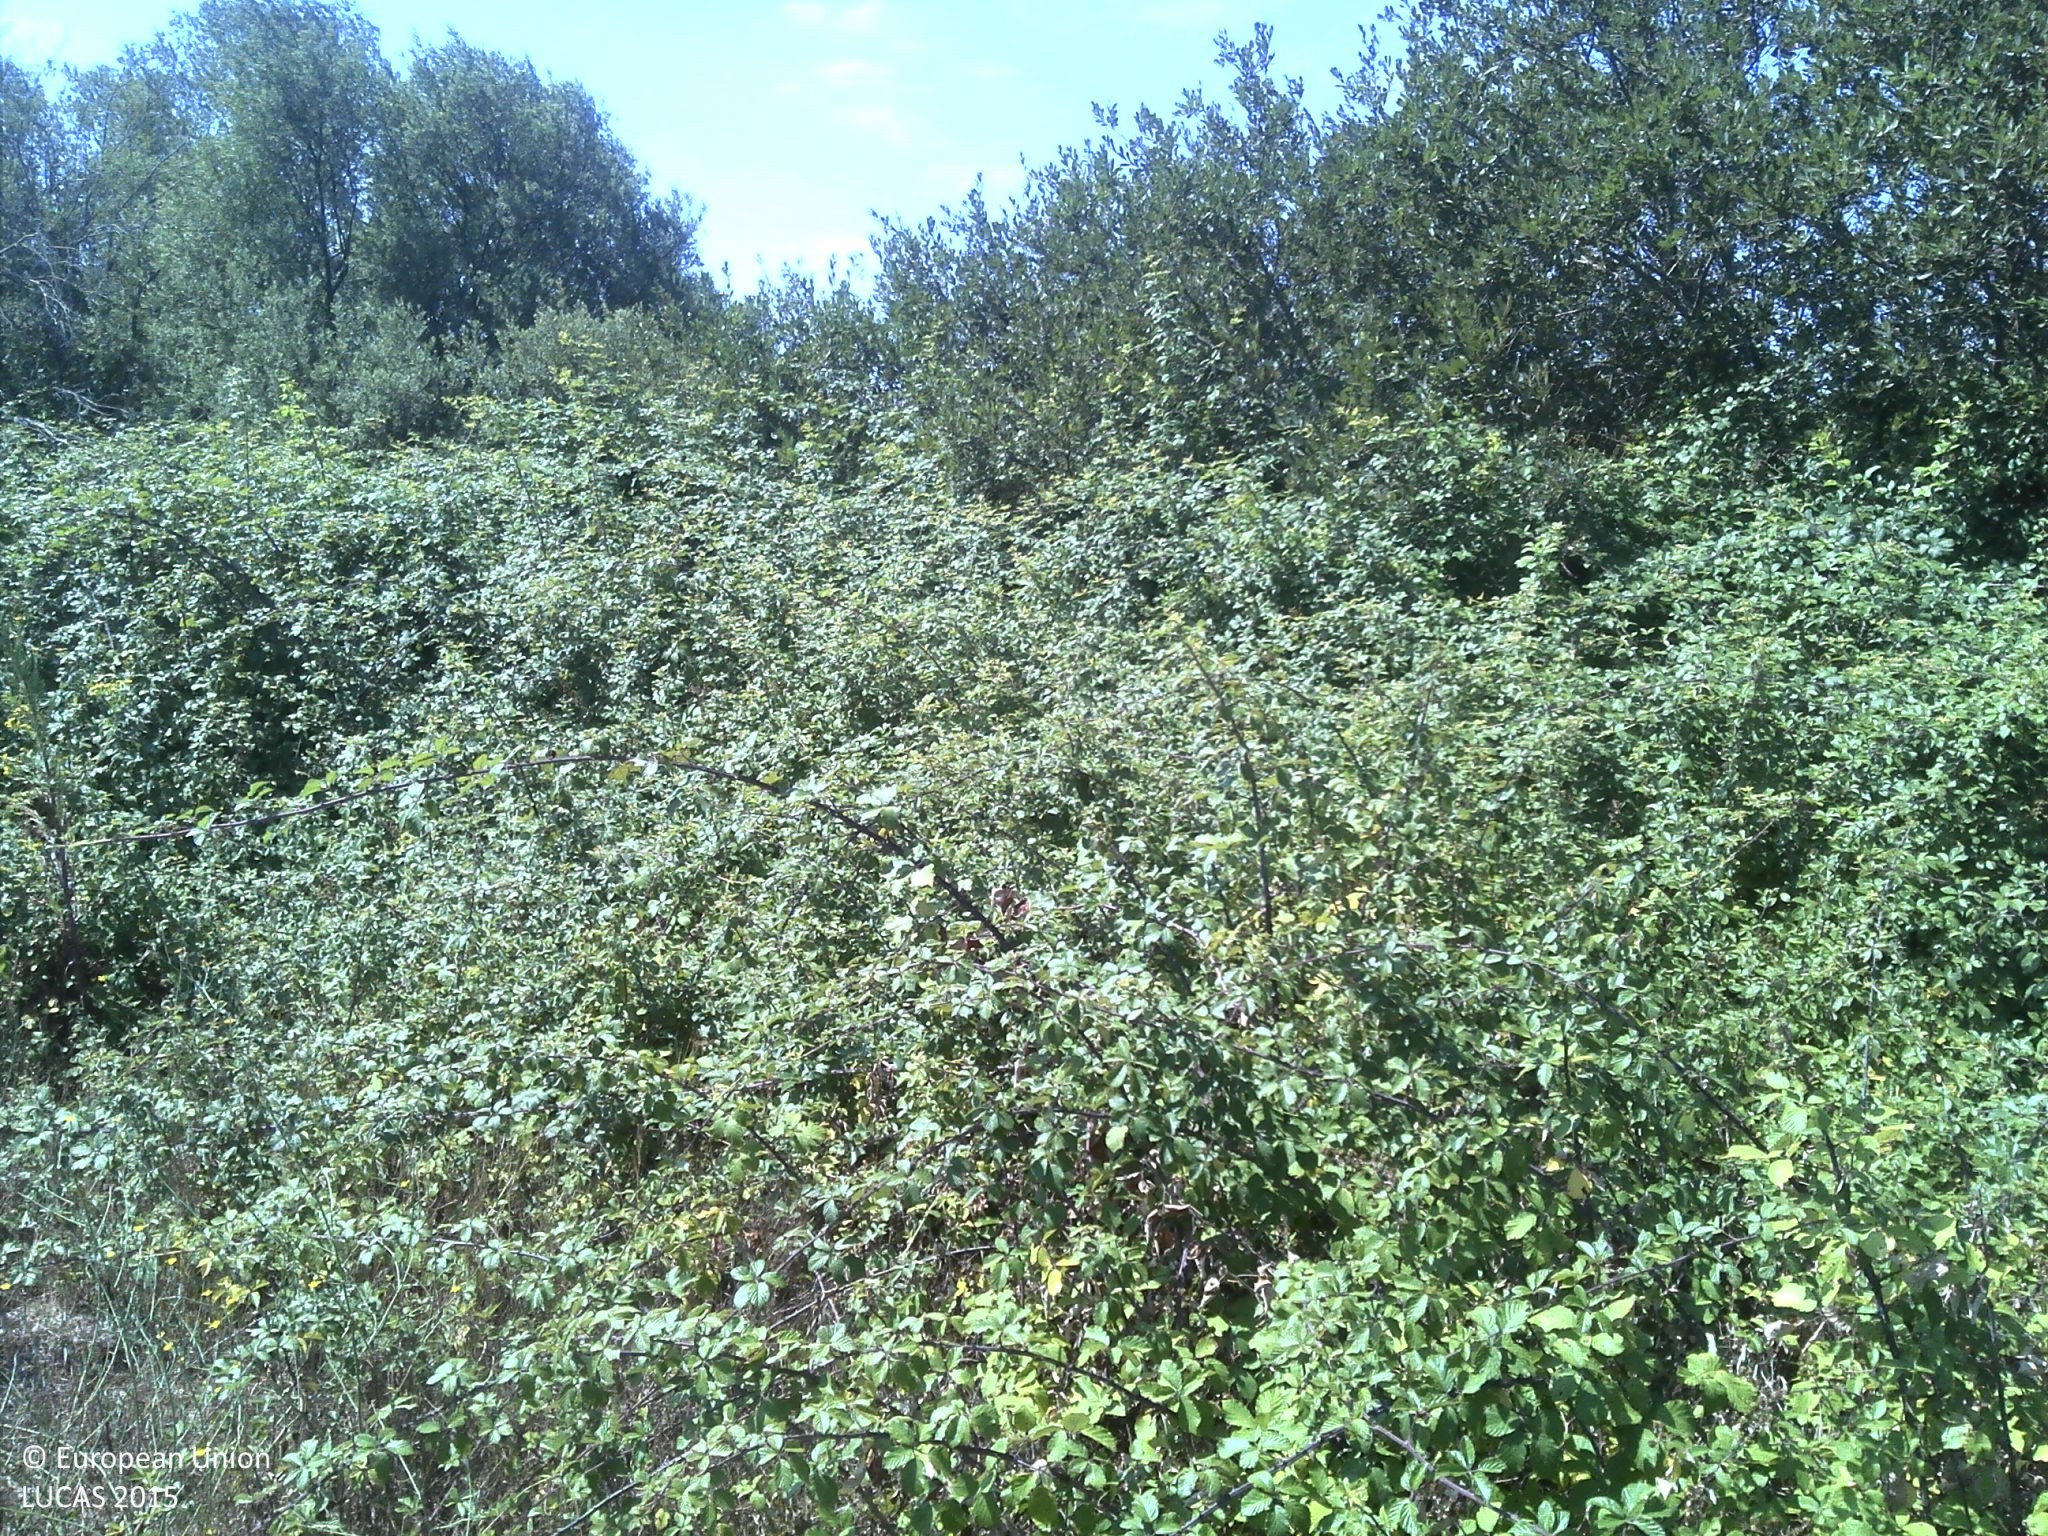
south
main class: Grassland
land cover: Grassland without tree/shrub cover
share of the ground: 25 - 50 %
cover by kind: unconsolidated bare surface 60 %, herbaceous plants 40 %
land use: Agriculture (excluding fallow land and kitchen gardens)
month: July
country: PT
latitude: 39.0643
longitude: -8.3078
